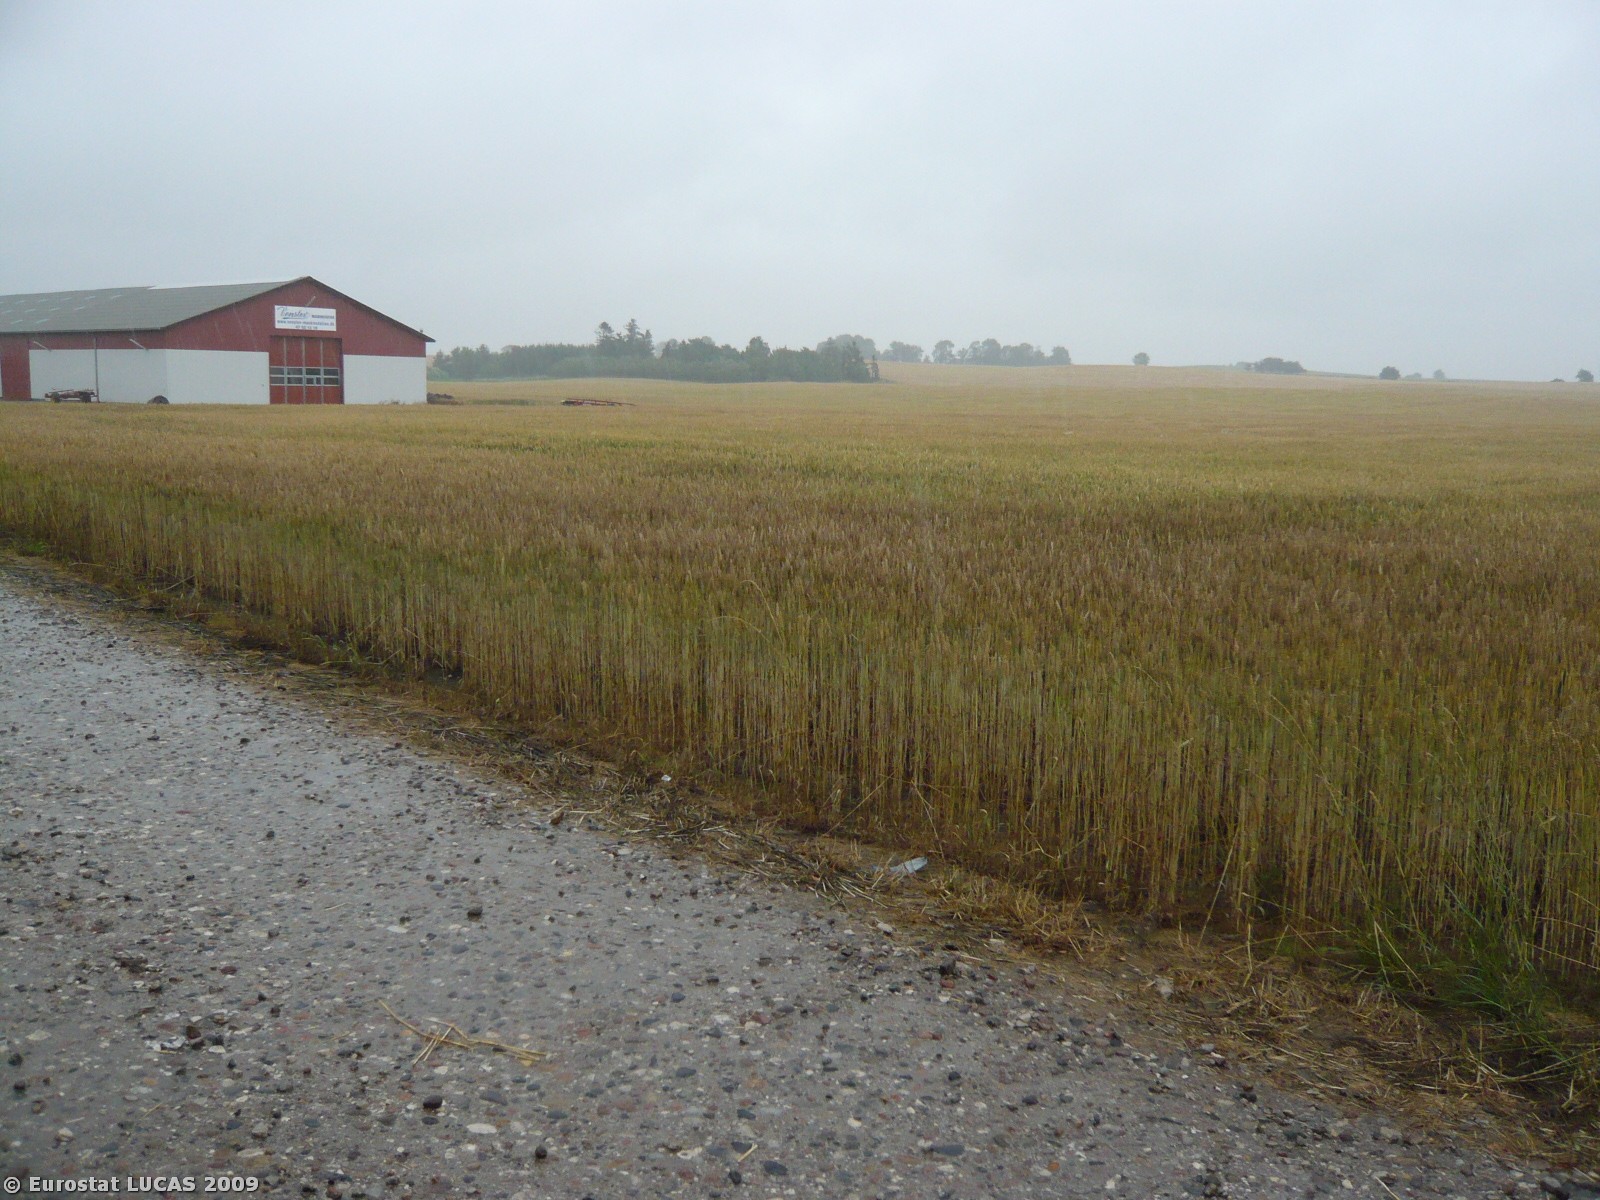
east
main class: Cropland
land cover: Common wheat
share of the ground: > 75 %
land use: Agriculture (excluding fallow land and kitchen gardens)
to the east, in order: Common wheat; Broadleaved woodland; Grassland without tree/shrub cover; Artificial constructions in urban areas; Grassland with sparse tree/shrub cover; Common wheat
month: July
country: DK
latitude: 55.7957
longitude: 11.9282
